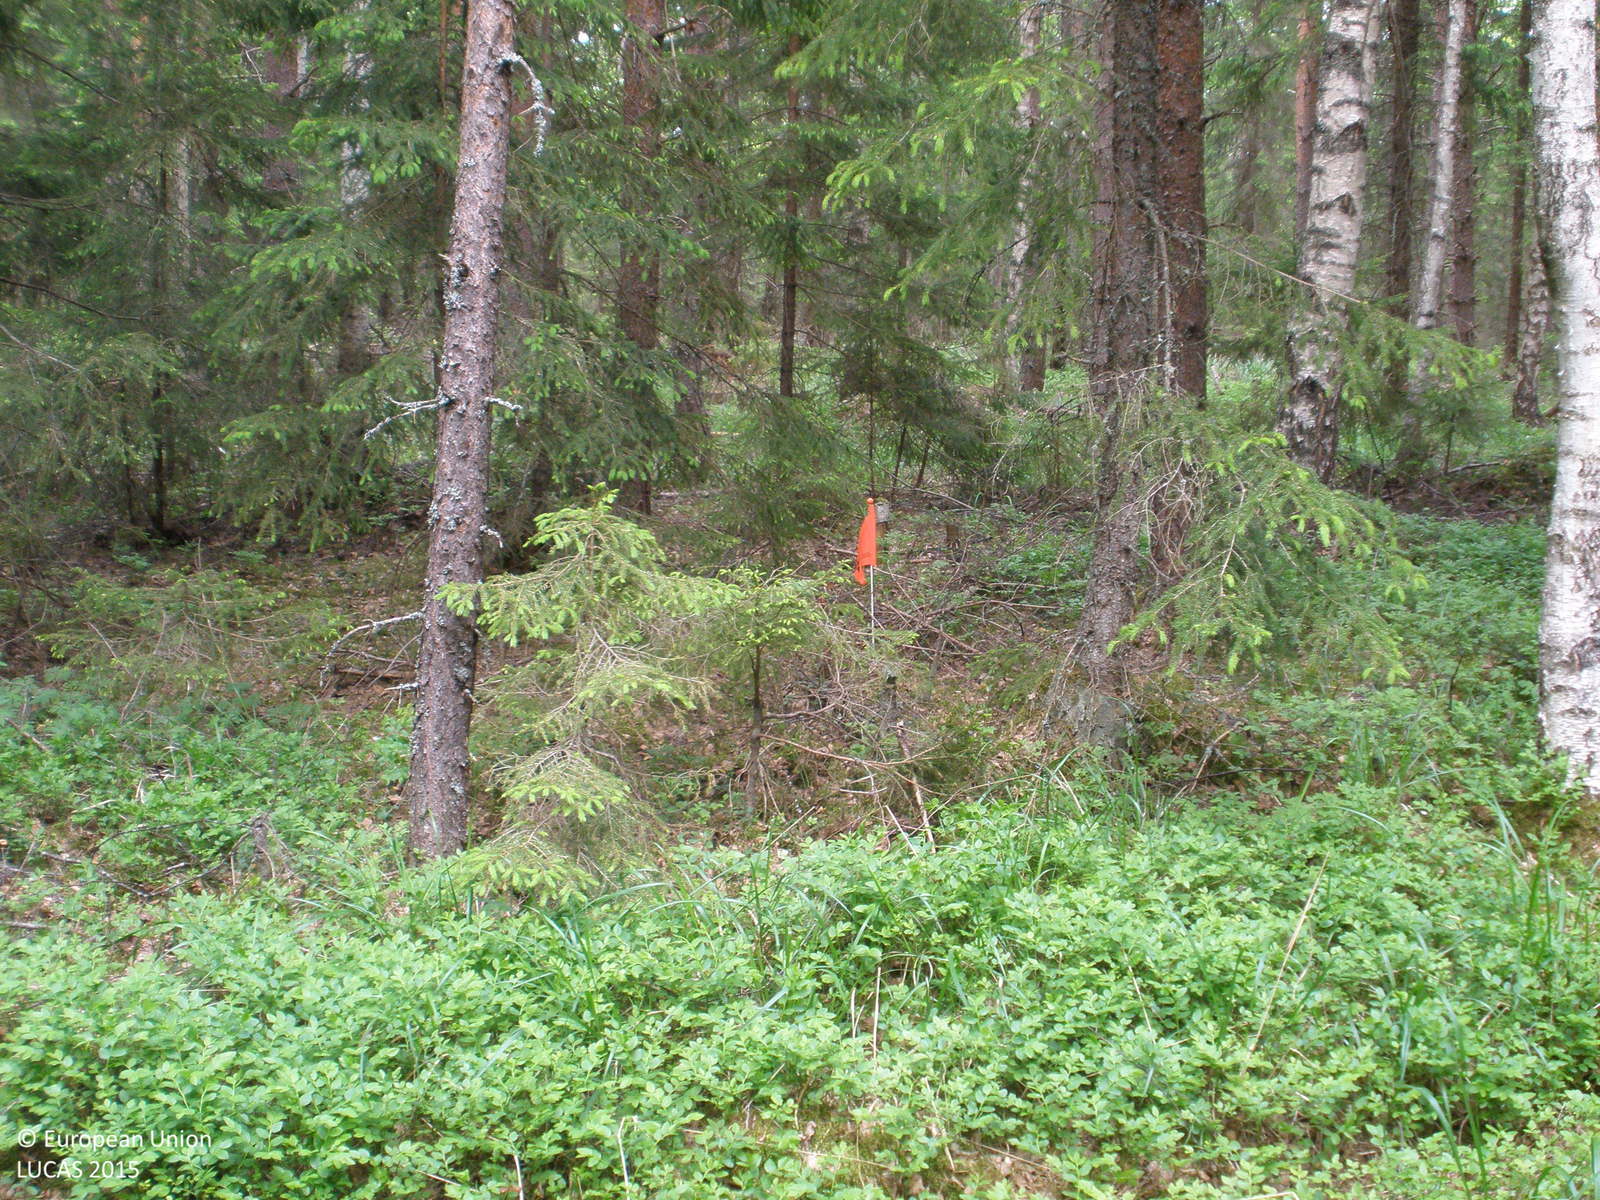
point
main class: Woodland
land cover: Pine dominated mixed woodland
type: boreal forest
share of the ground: > 75 %
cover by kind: coniferous forest trees 60 %, broadleaved forest trees 25 %, herbaceous plants 10 %, shrubs 5 %
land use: Forestry
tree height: > 5 m
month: June
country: FI
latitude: 61.0152
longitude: 24.2117
